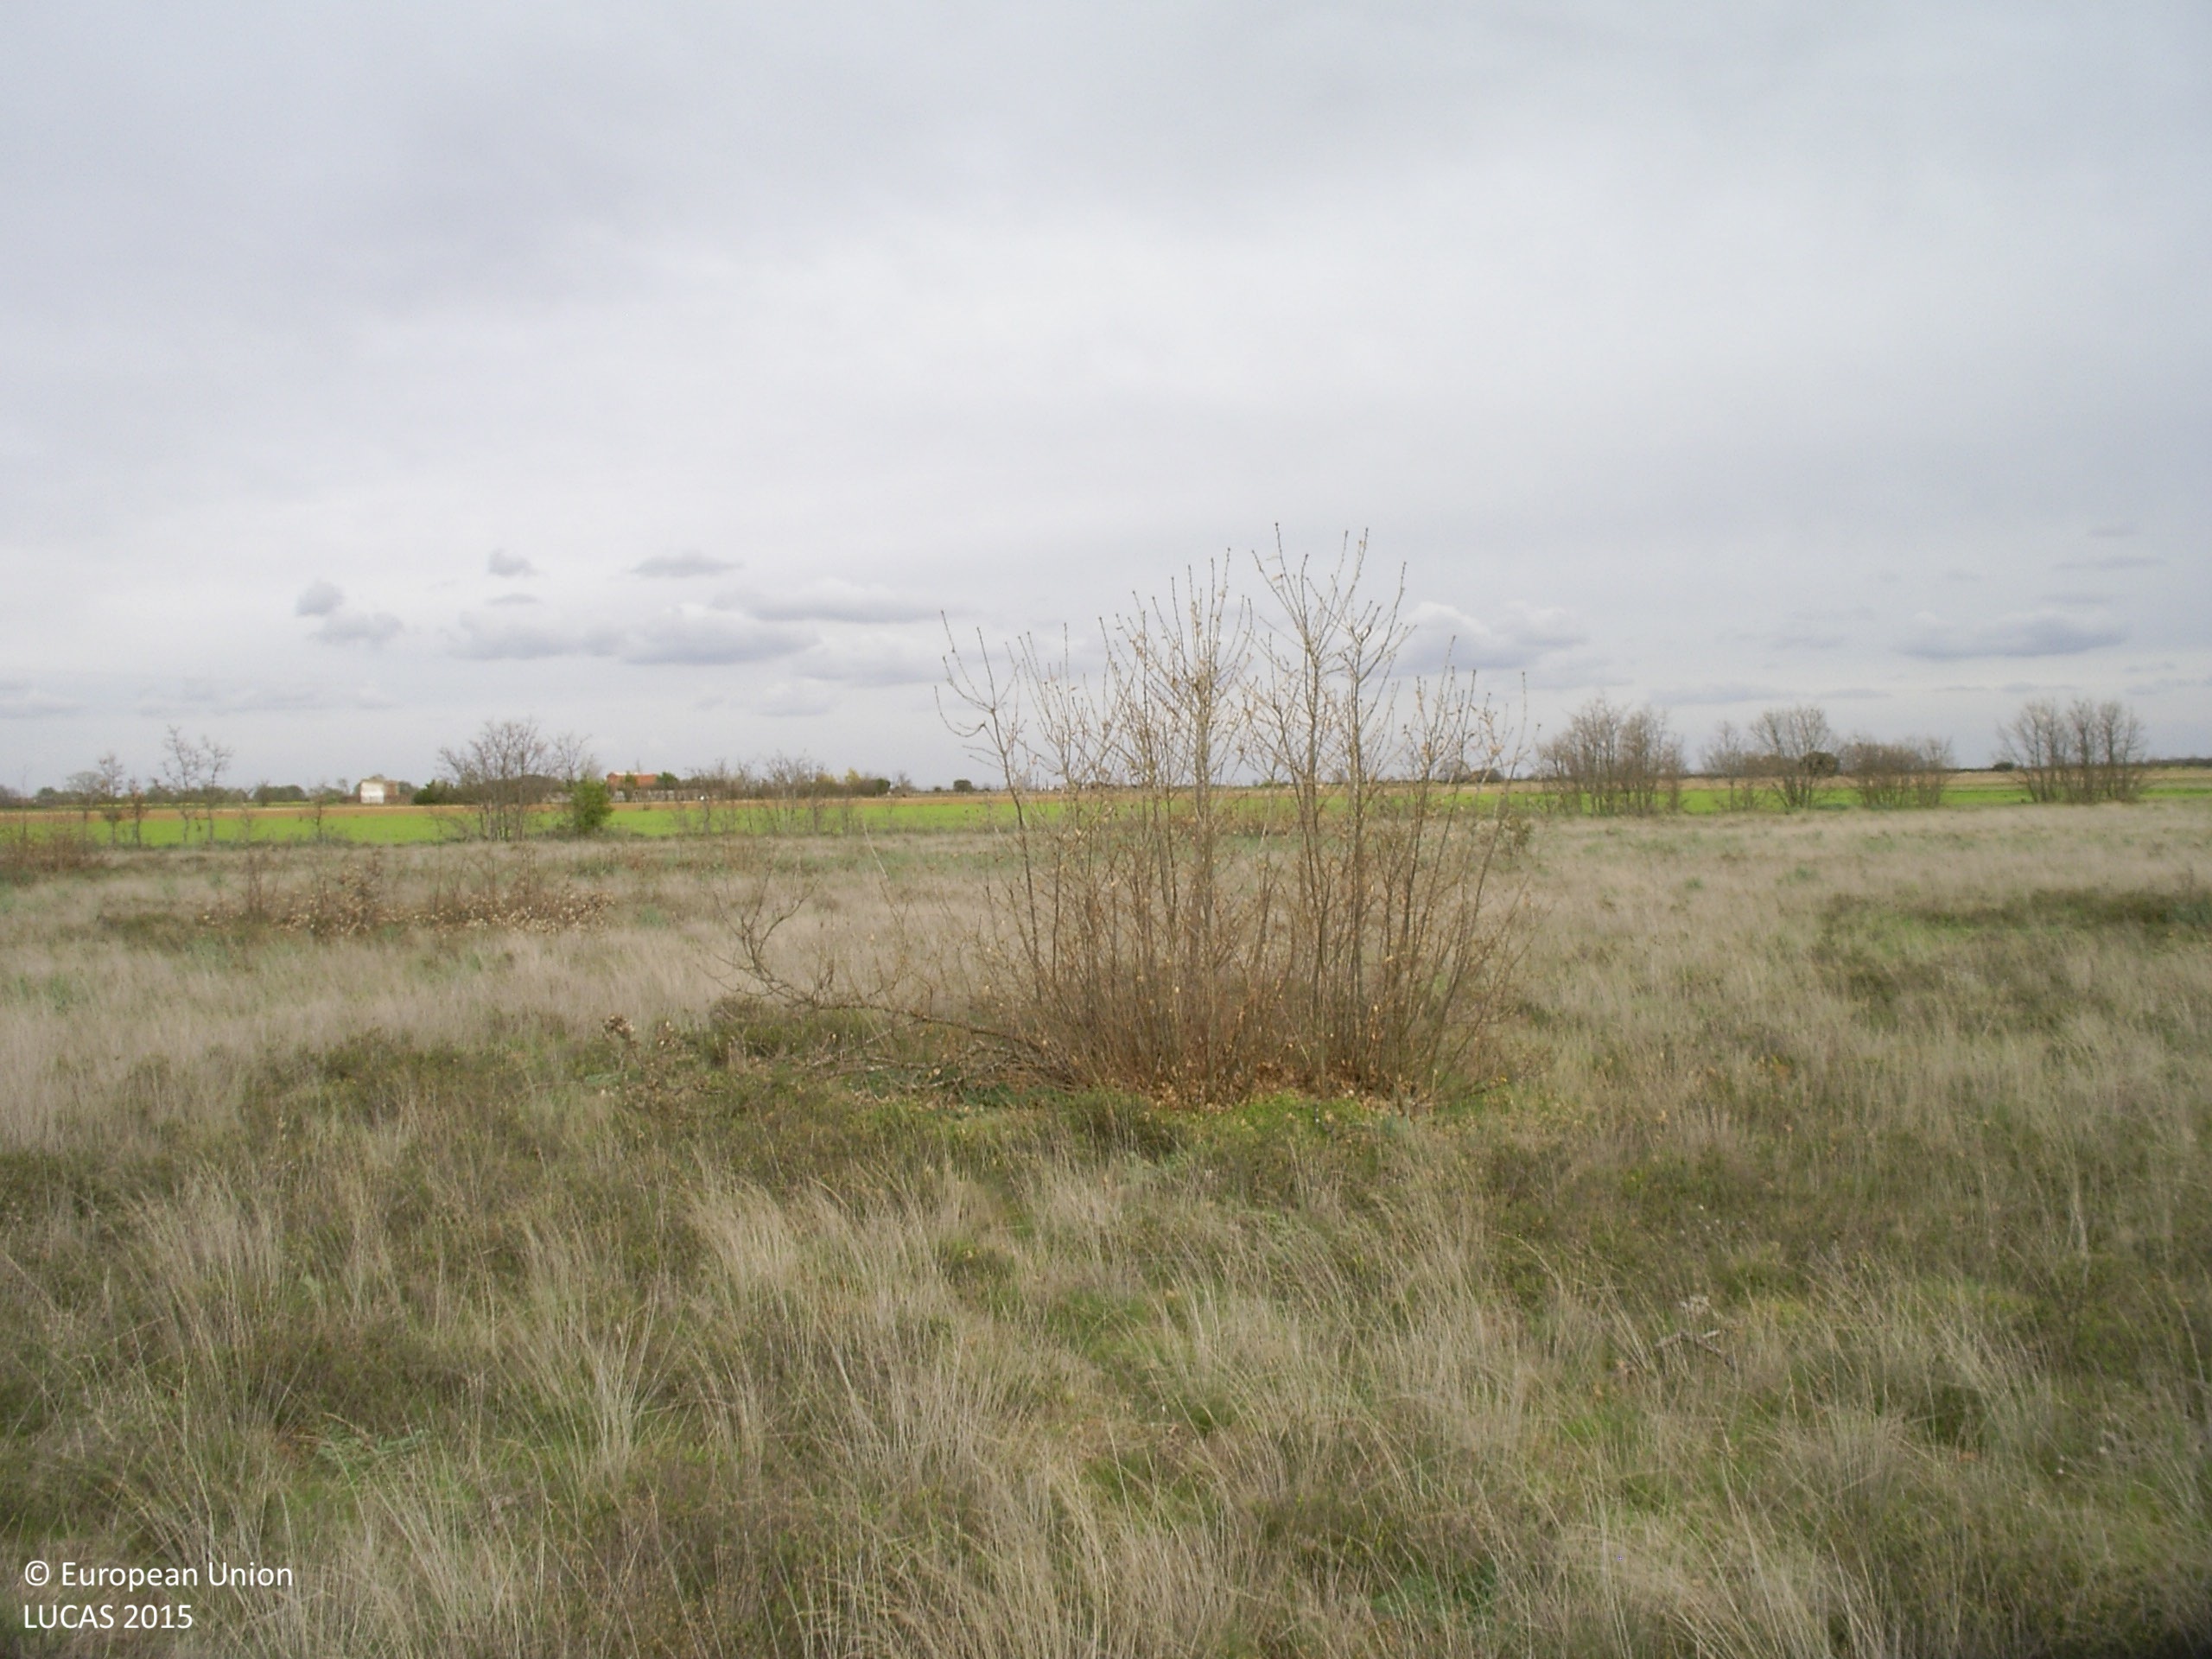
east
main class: Grassland
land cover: Grassland with sparse tree/shrub cover
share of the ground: > 75 %
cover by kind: herbaceous plants 95 %, coniferous forest trees 5 %
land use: Abandoned areas
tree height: < 5 m
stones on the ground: < 10 %
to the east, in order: Grassland with sparse tree/shrub cover; Tracks; Groves; Rape and turnip rape; Grass margins; Ditches and canals; Electric lines; Tracks; Other bare soil
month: April
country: ES
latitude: 42.5023
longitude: -5.7117
